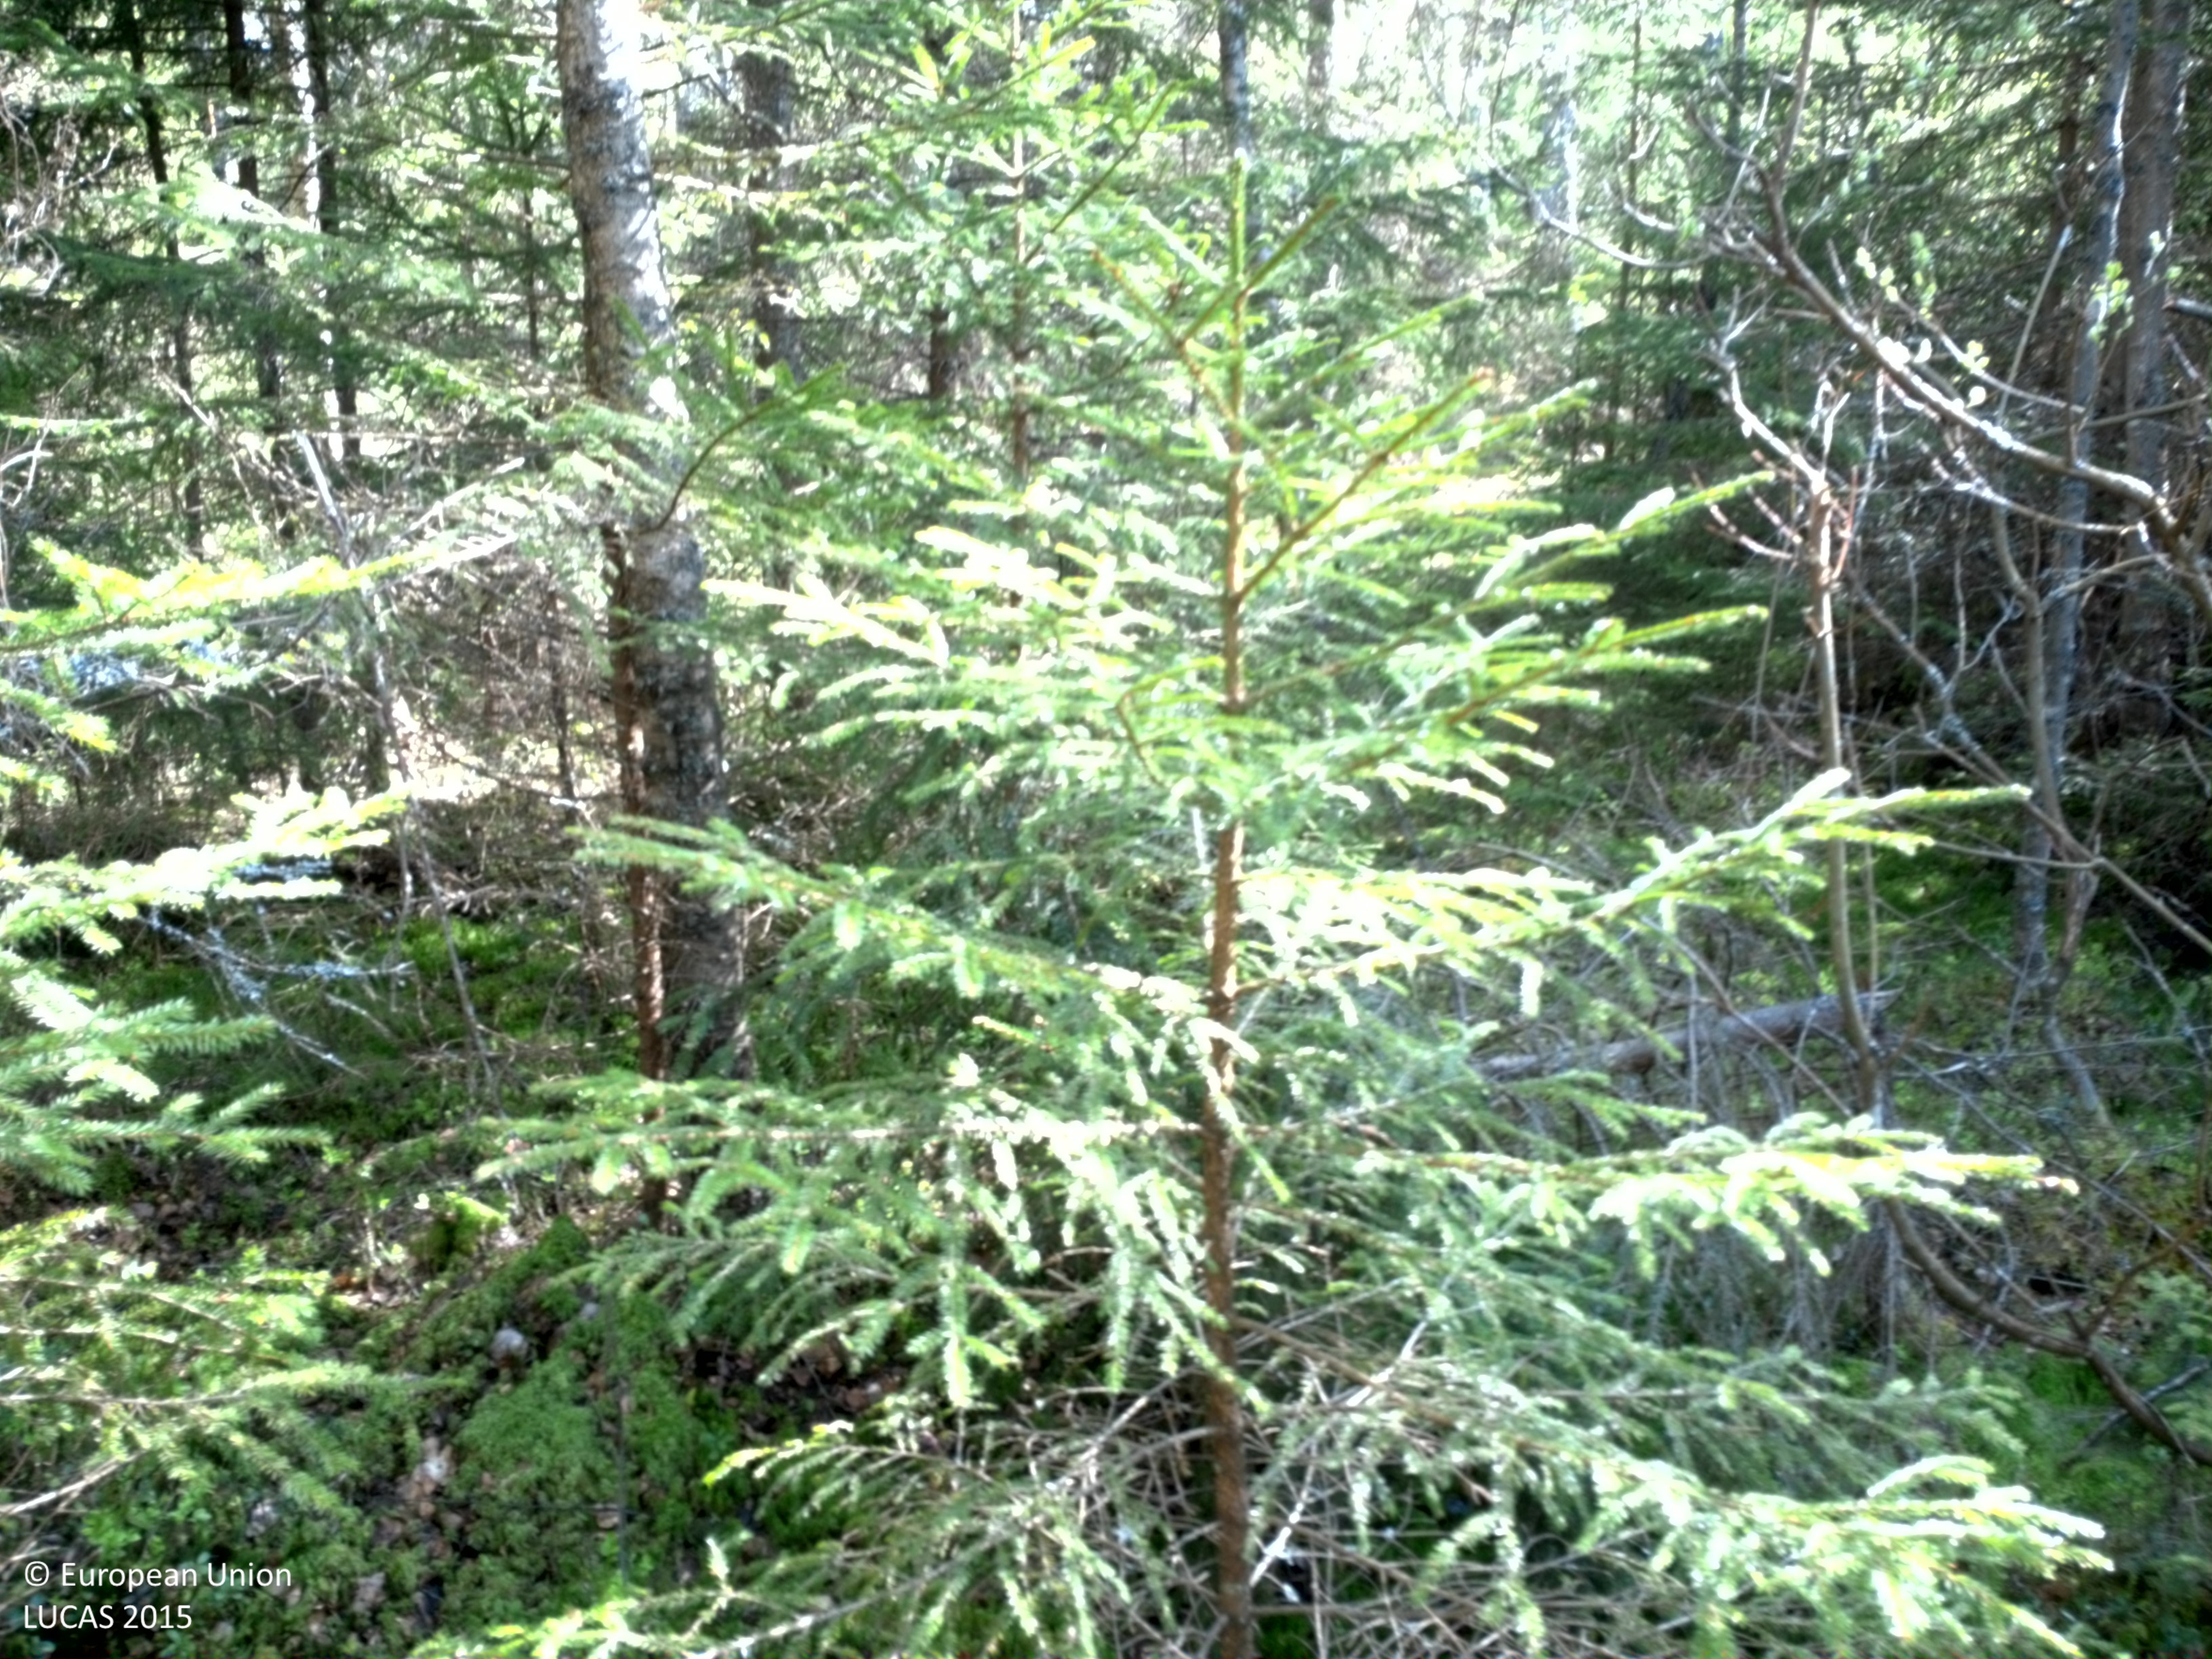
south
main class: Woodland
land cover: Spruce dominated mixed woodland
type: boreal forest
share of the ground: > 75 %
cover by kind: coniferous forest trees 75 %, broadleaved forest trees 25 %
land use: Forestry
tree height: > 5 m
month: May
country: SE
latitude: 56.5421
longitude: 15.4145
